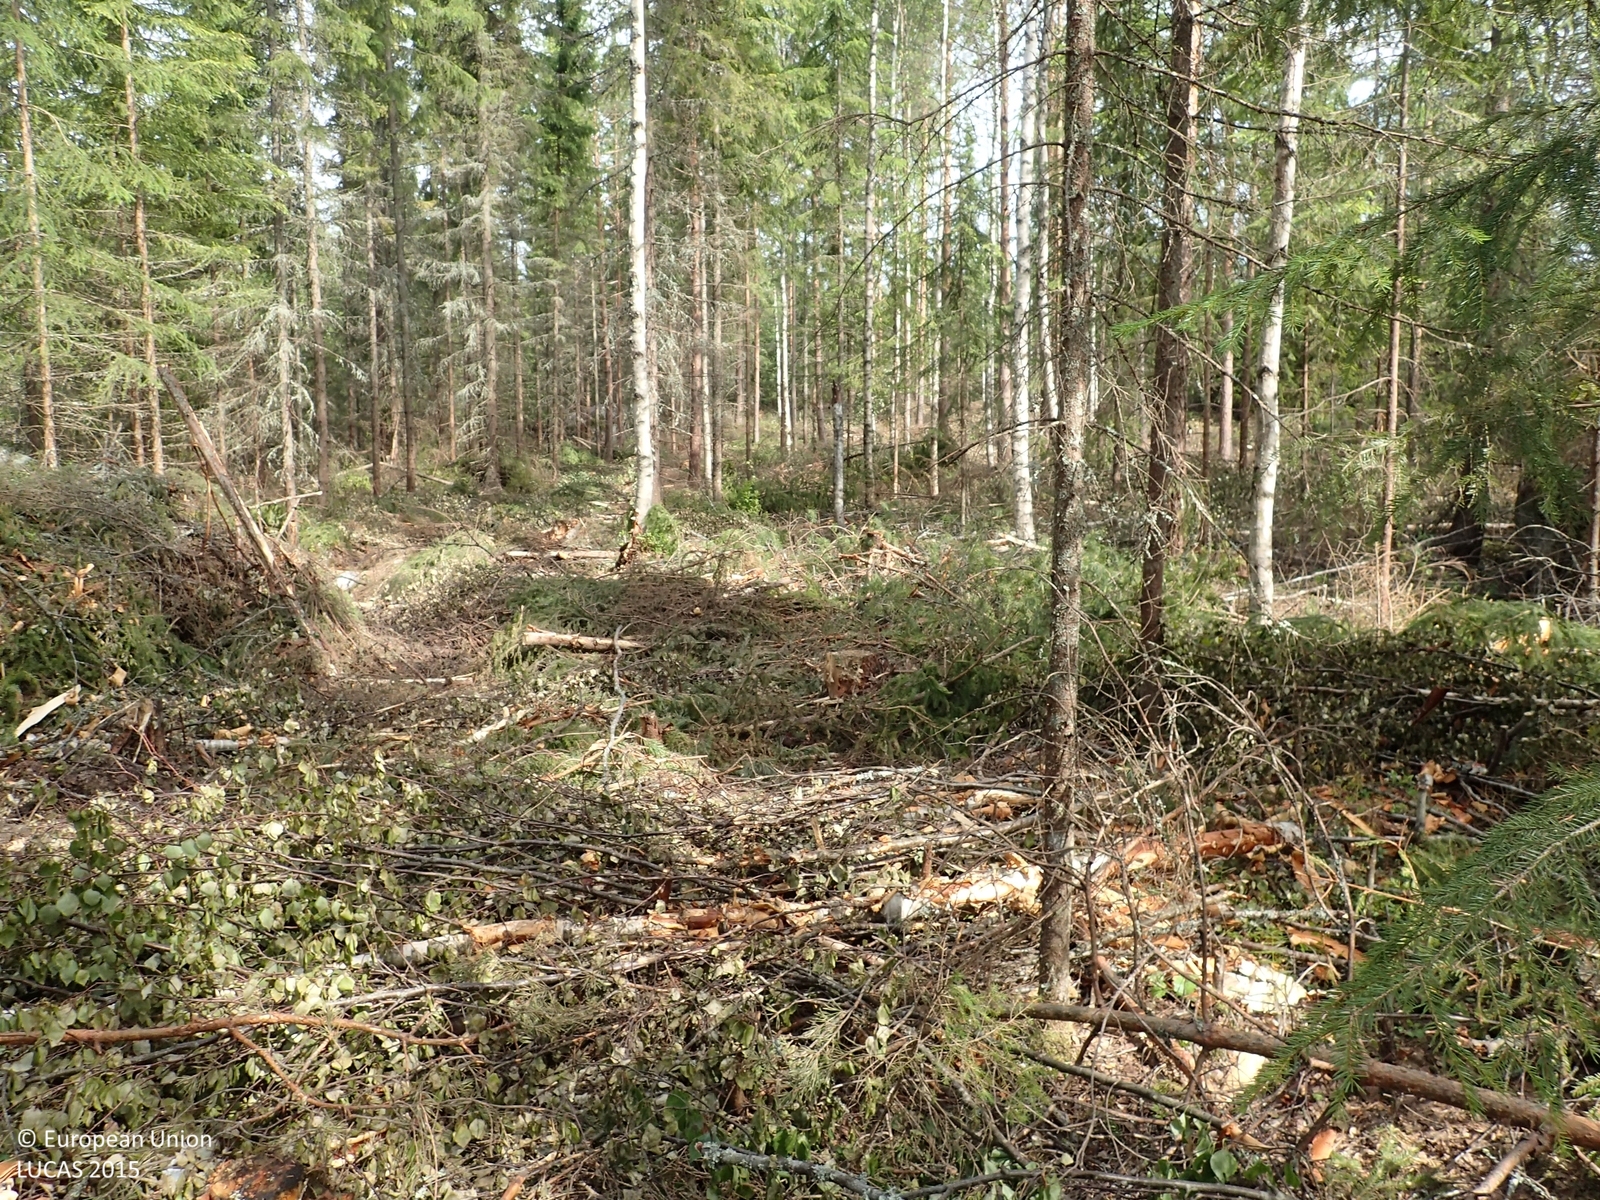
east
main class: Woodland
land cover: Spruce dominated coniferous woodland
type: boreal forest
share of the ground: 25 - 50 %
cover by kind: unconsolidated bare surface 50 %, coniferous forest trees 30 %, shrubs 15 %, broadleaved forest trees 5 %
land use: Forestry
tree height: > 5 m
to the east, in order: Spruce dominated coniferous woodland; Tracks; Spruce dominated mixed woodland; Ditches and canals; Abandoned hedges; Electric lines; Paved roads, cycling and walking lanes; Spruce dominated mixed woodland; Tracks; Spruce dominated coniferous woodland; Other coniferous woodland
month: July
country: FI
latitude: 62.9589
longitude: 21.4549
